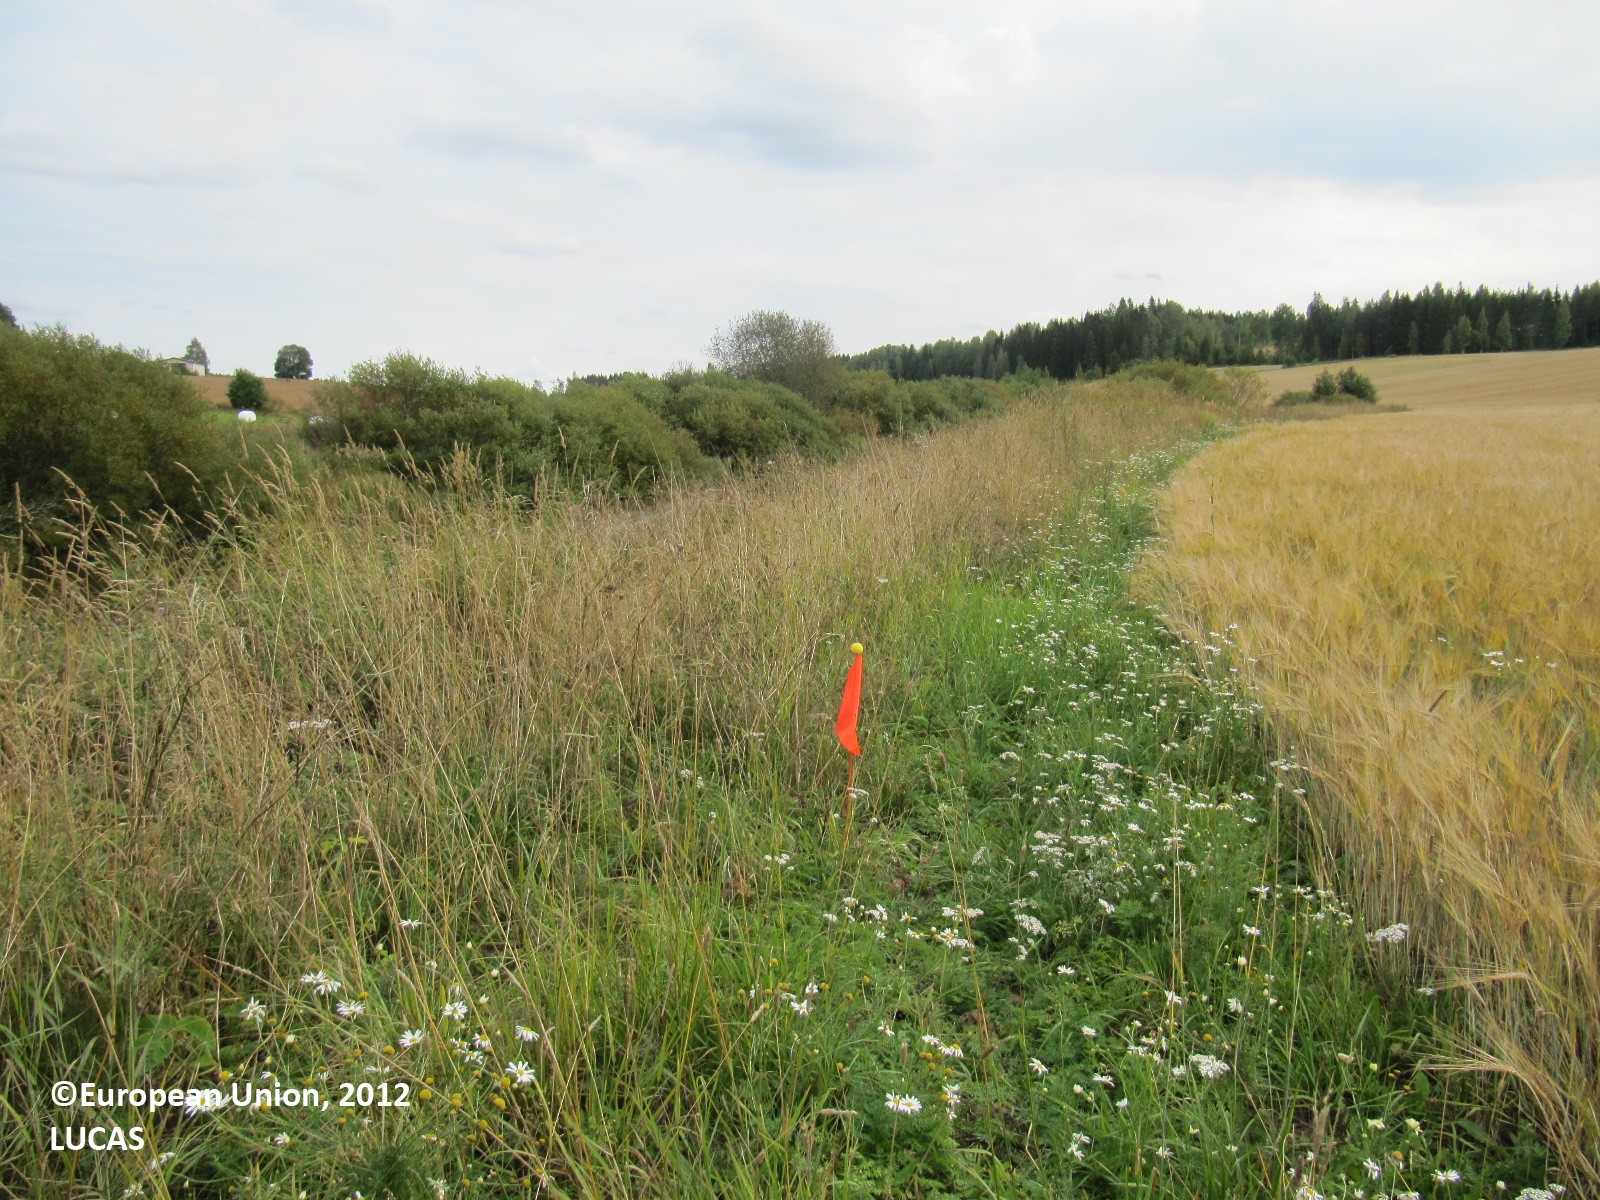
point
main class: Grassland
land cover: Grassland with sparse tree/shrub cover
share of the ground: > 75 %
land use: Agriculture (excluding fallow land and kitchen gardens)
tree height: < 5 m
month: August
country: FI
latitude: 61.1323
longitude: 22.9782
